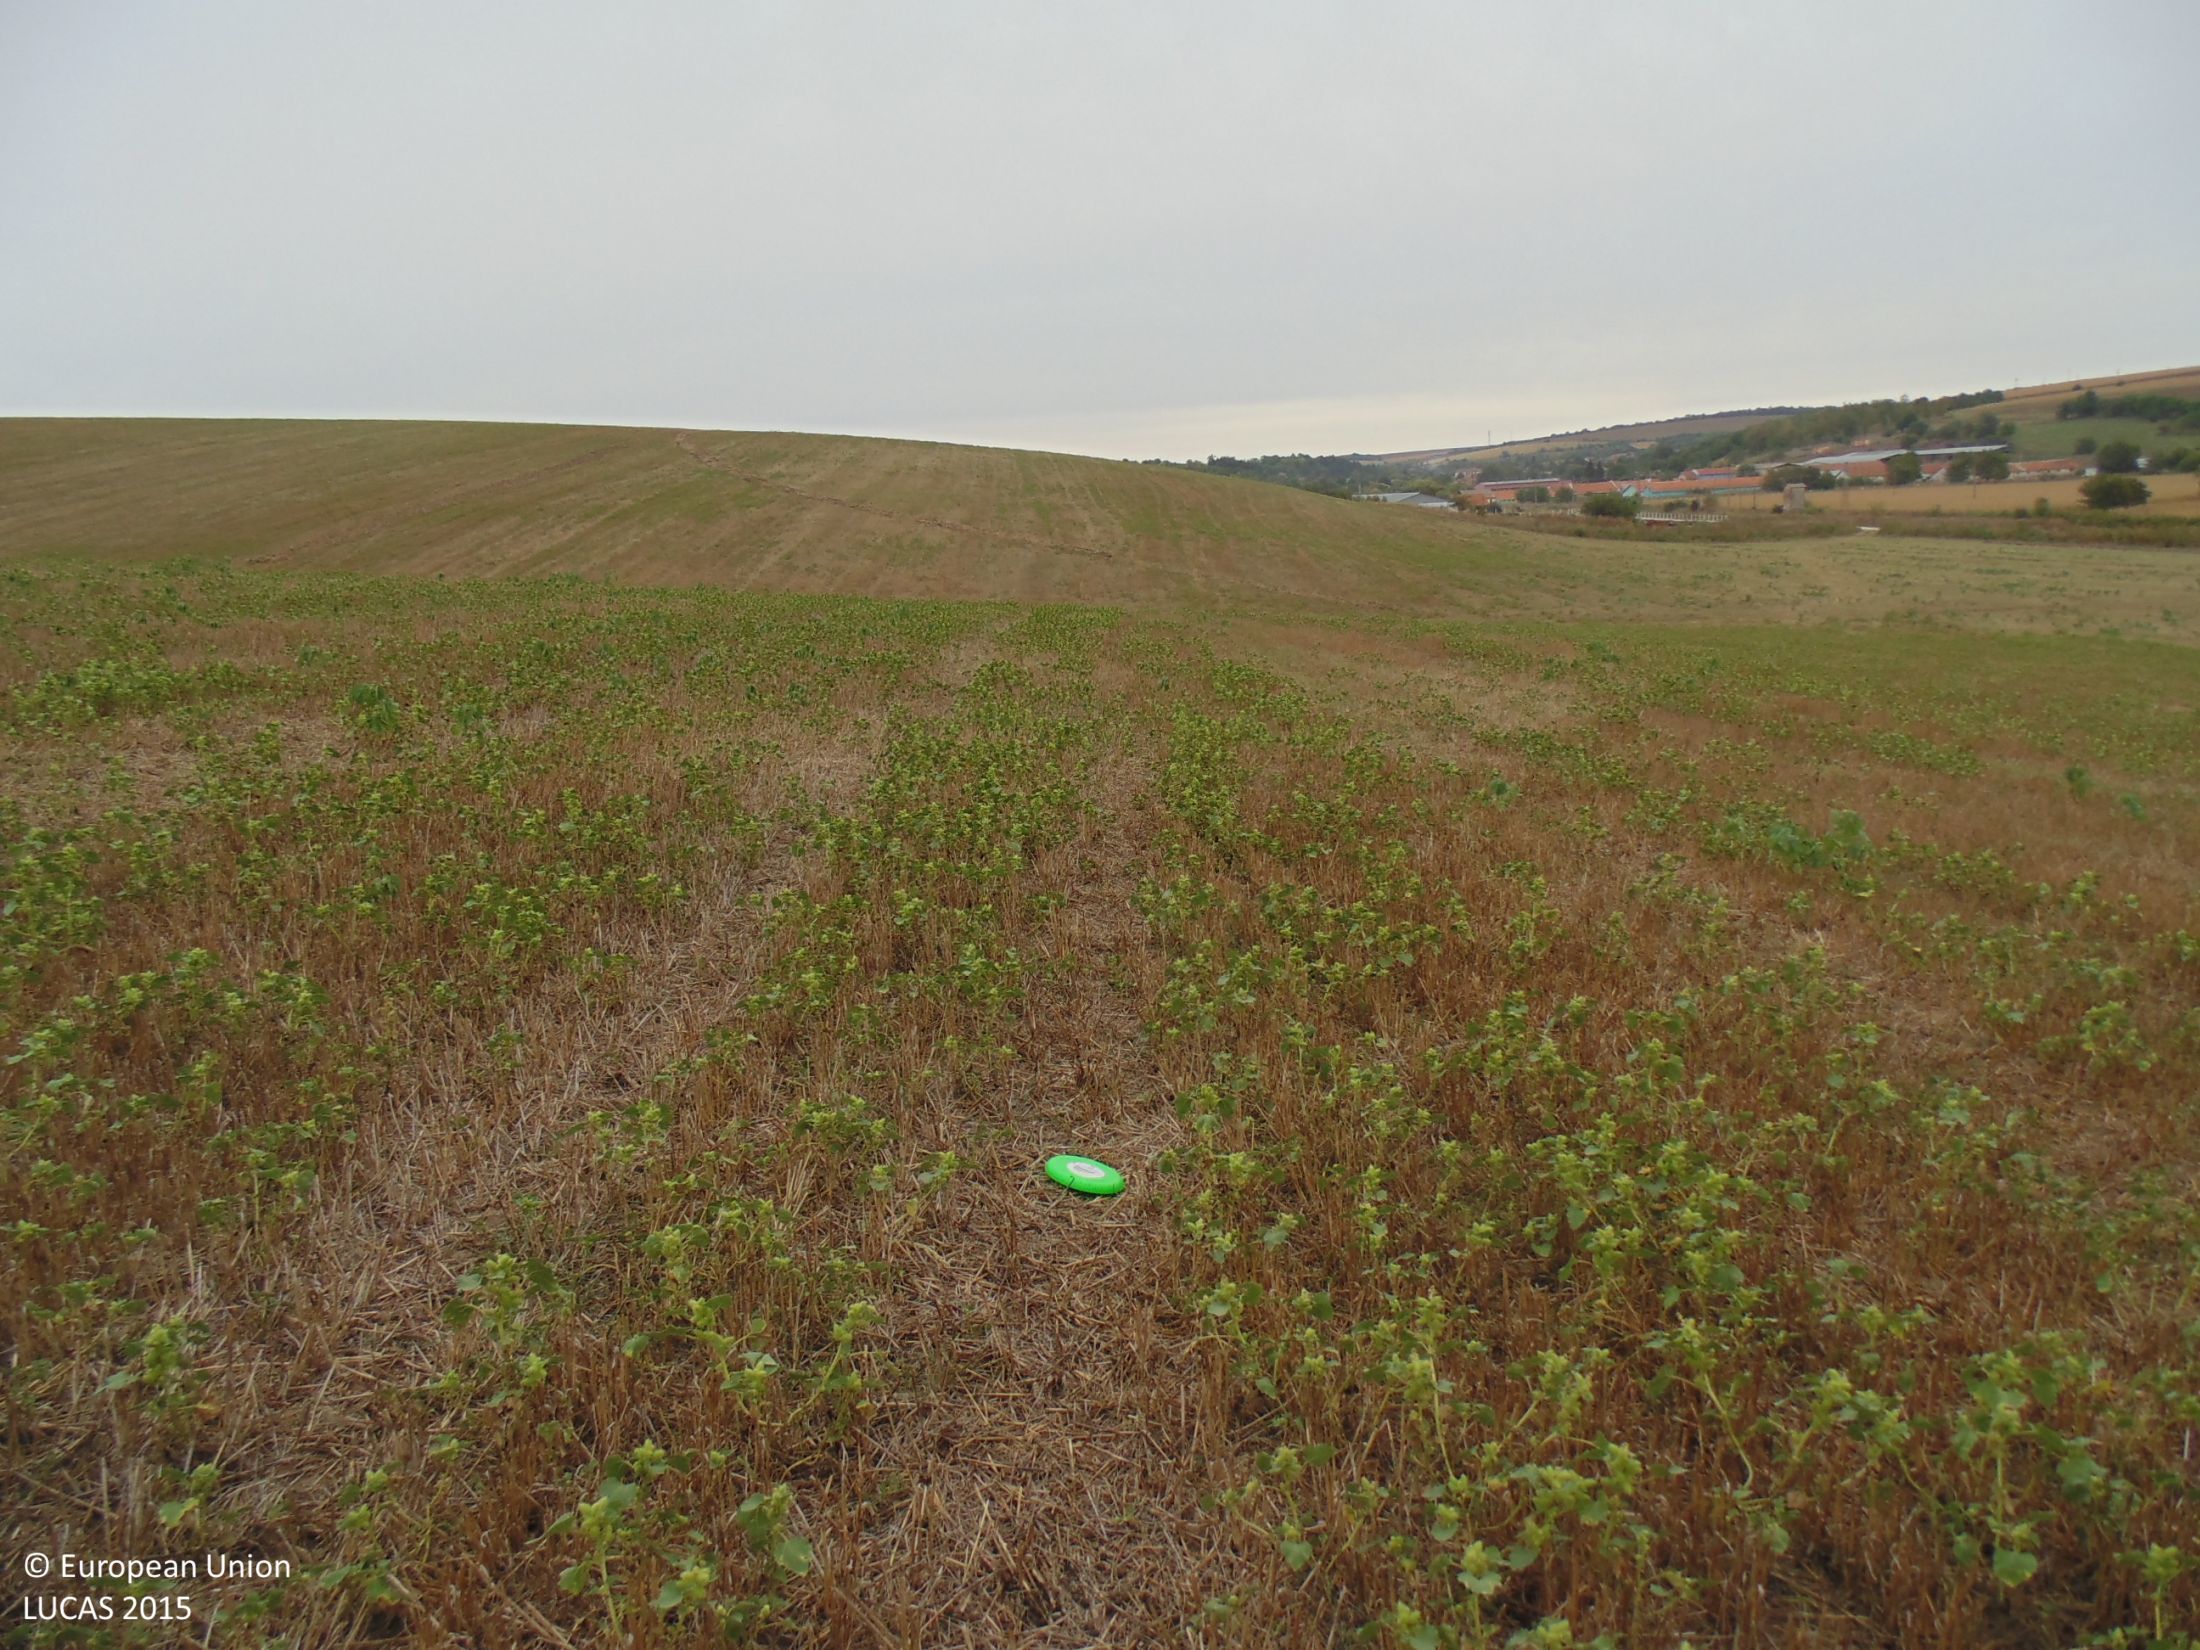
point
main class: Cropland
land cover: Common wheat
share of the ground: 10 - 25 %
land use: Agriculture (excluding fallow land and kitchen gardens)
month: September
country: BG
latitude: 44.0351
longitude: 27.1352
